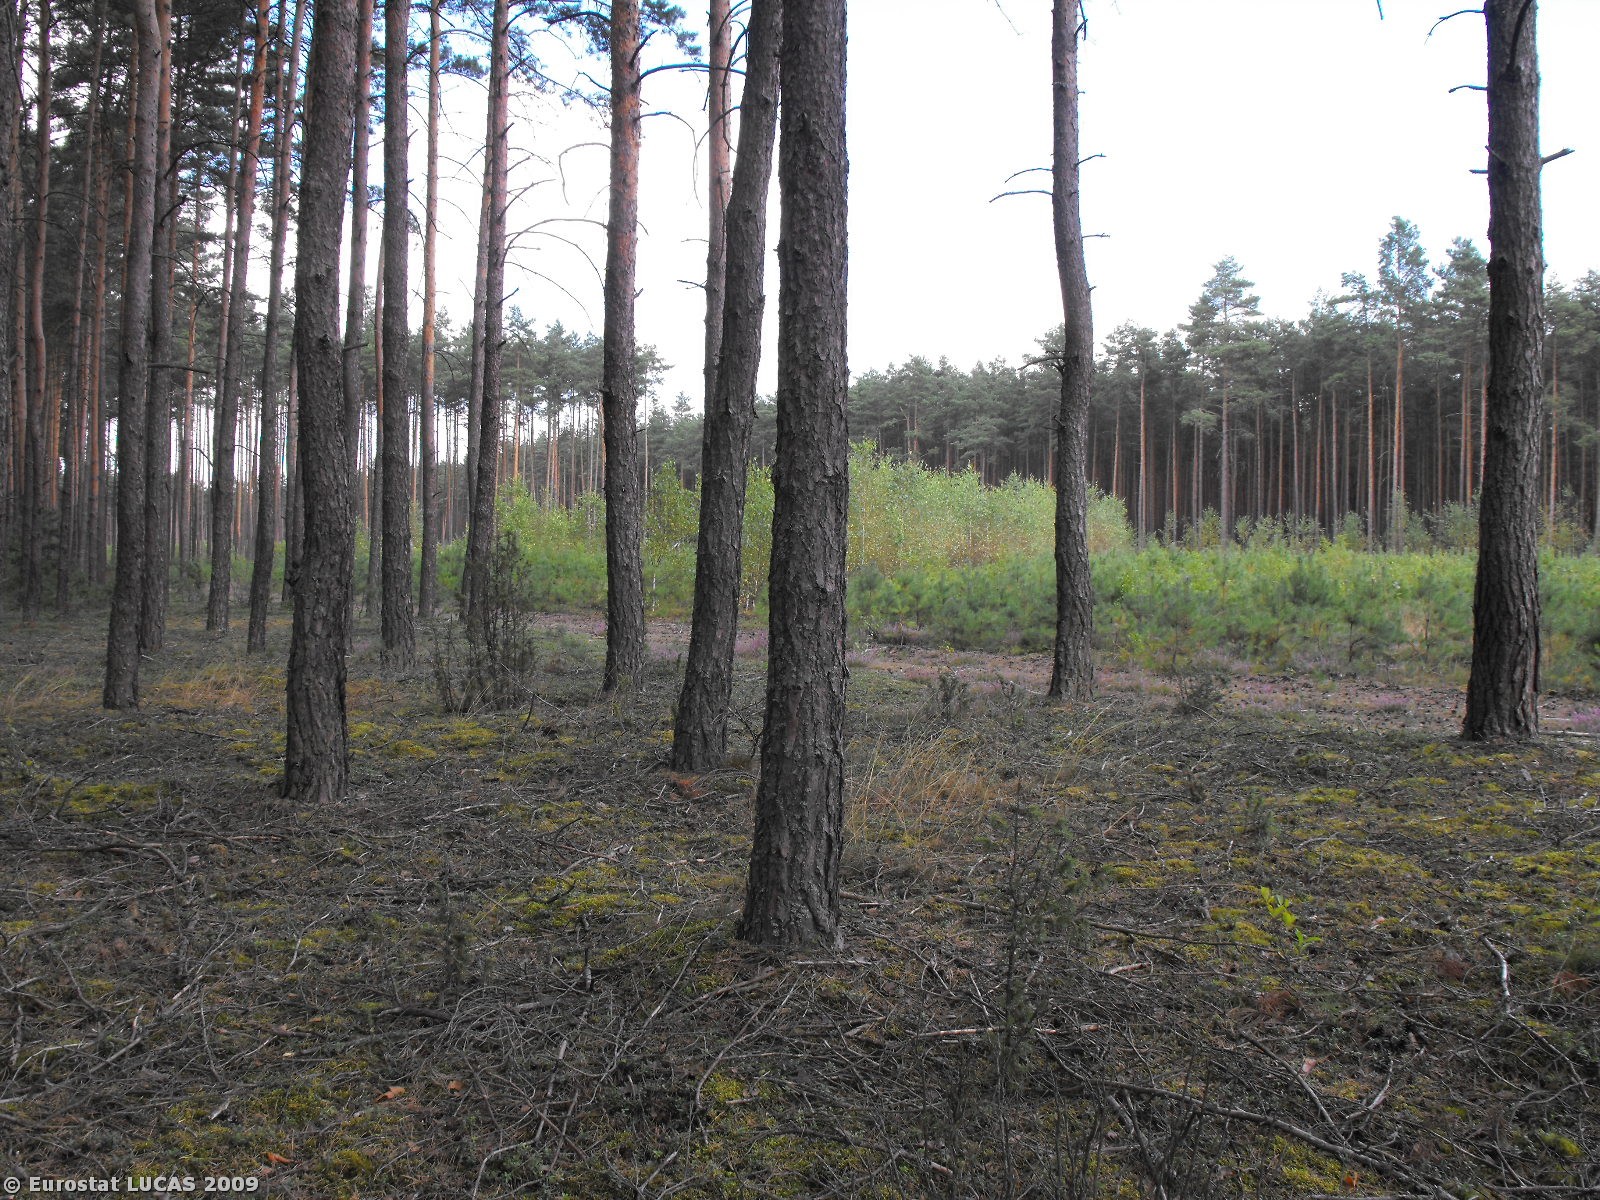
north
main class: Woodland
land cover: Coniferous woodland
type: hemiboreal forest and nemoral coniferous forest and mixed broadleaved-coniferous forest
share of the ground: > 75 %
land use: Forestry
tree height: > 5 m
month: September
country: PL
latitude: 52.7788
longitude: 16.4560
